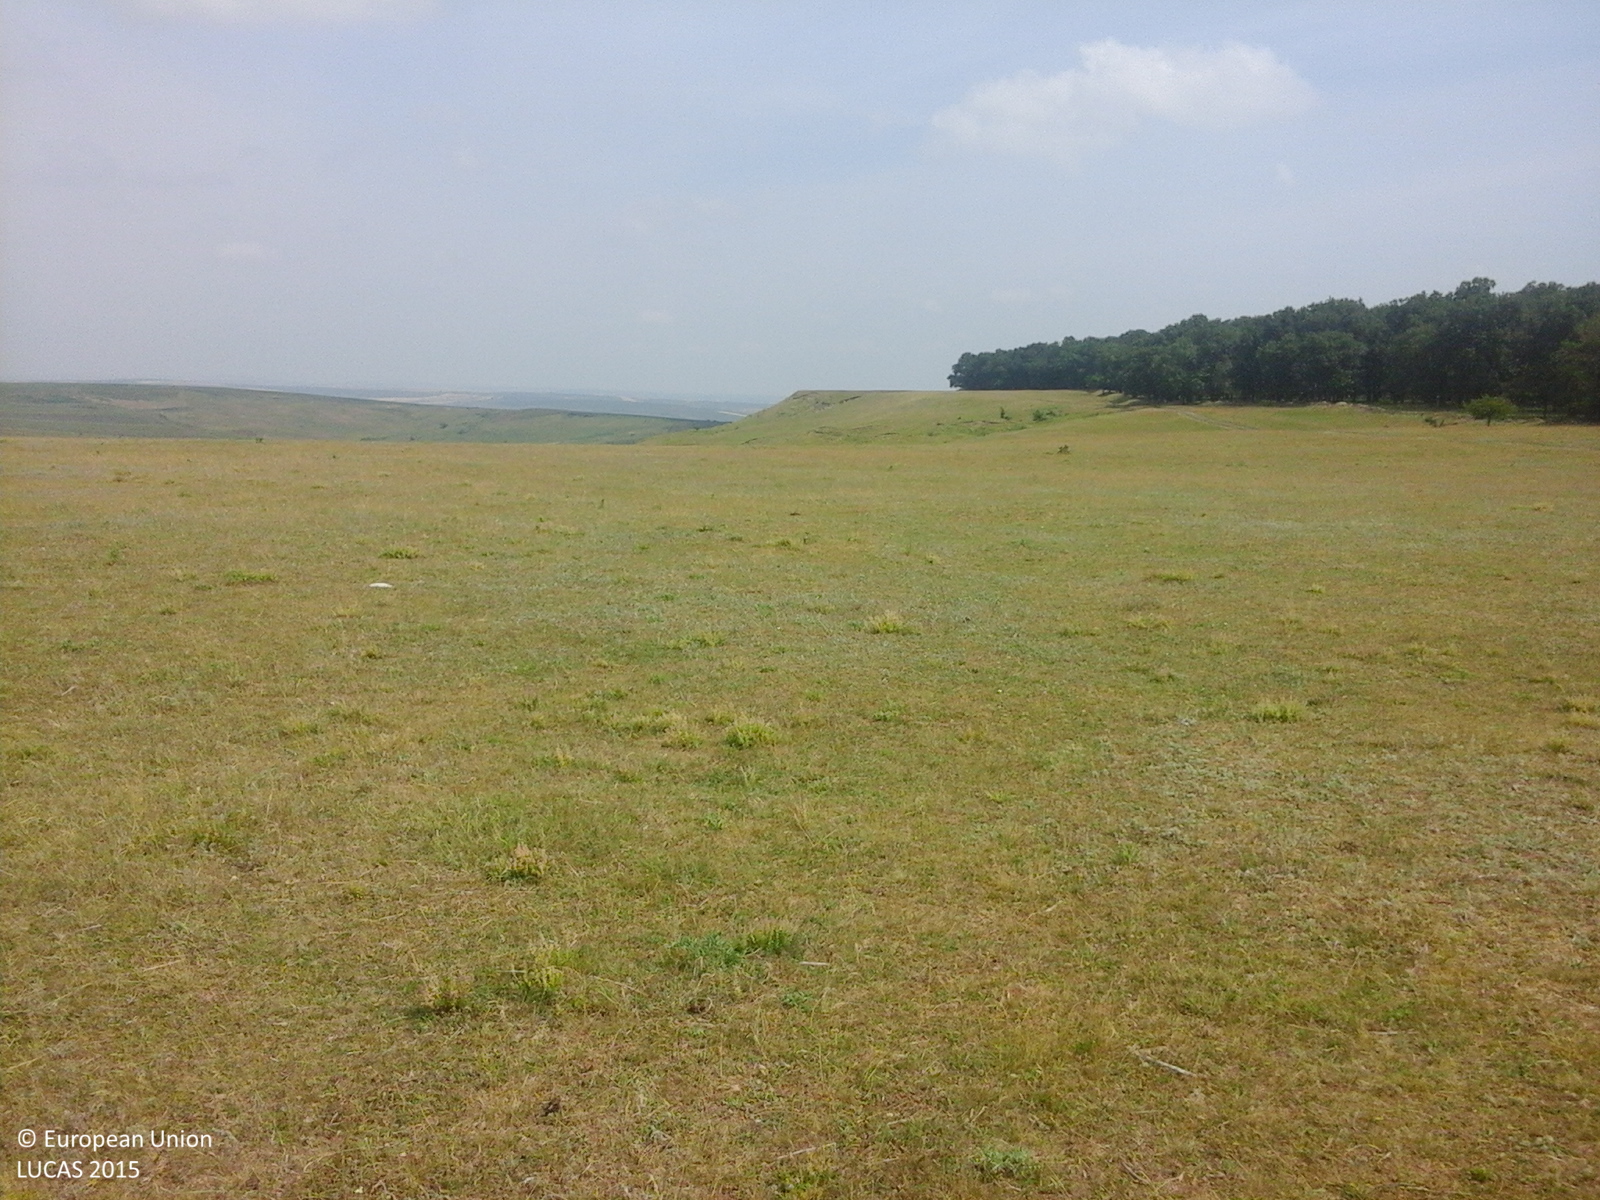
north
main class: Grassland
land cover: Grassland without tree/shrub cover
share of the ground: > 75 %
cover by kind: herbaceous plants 100 %
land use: Agriculture (excluding fallow land and kitchen gardens)
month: June
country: RO
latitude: 47.3662
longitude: 27.0122
